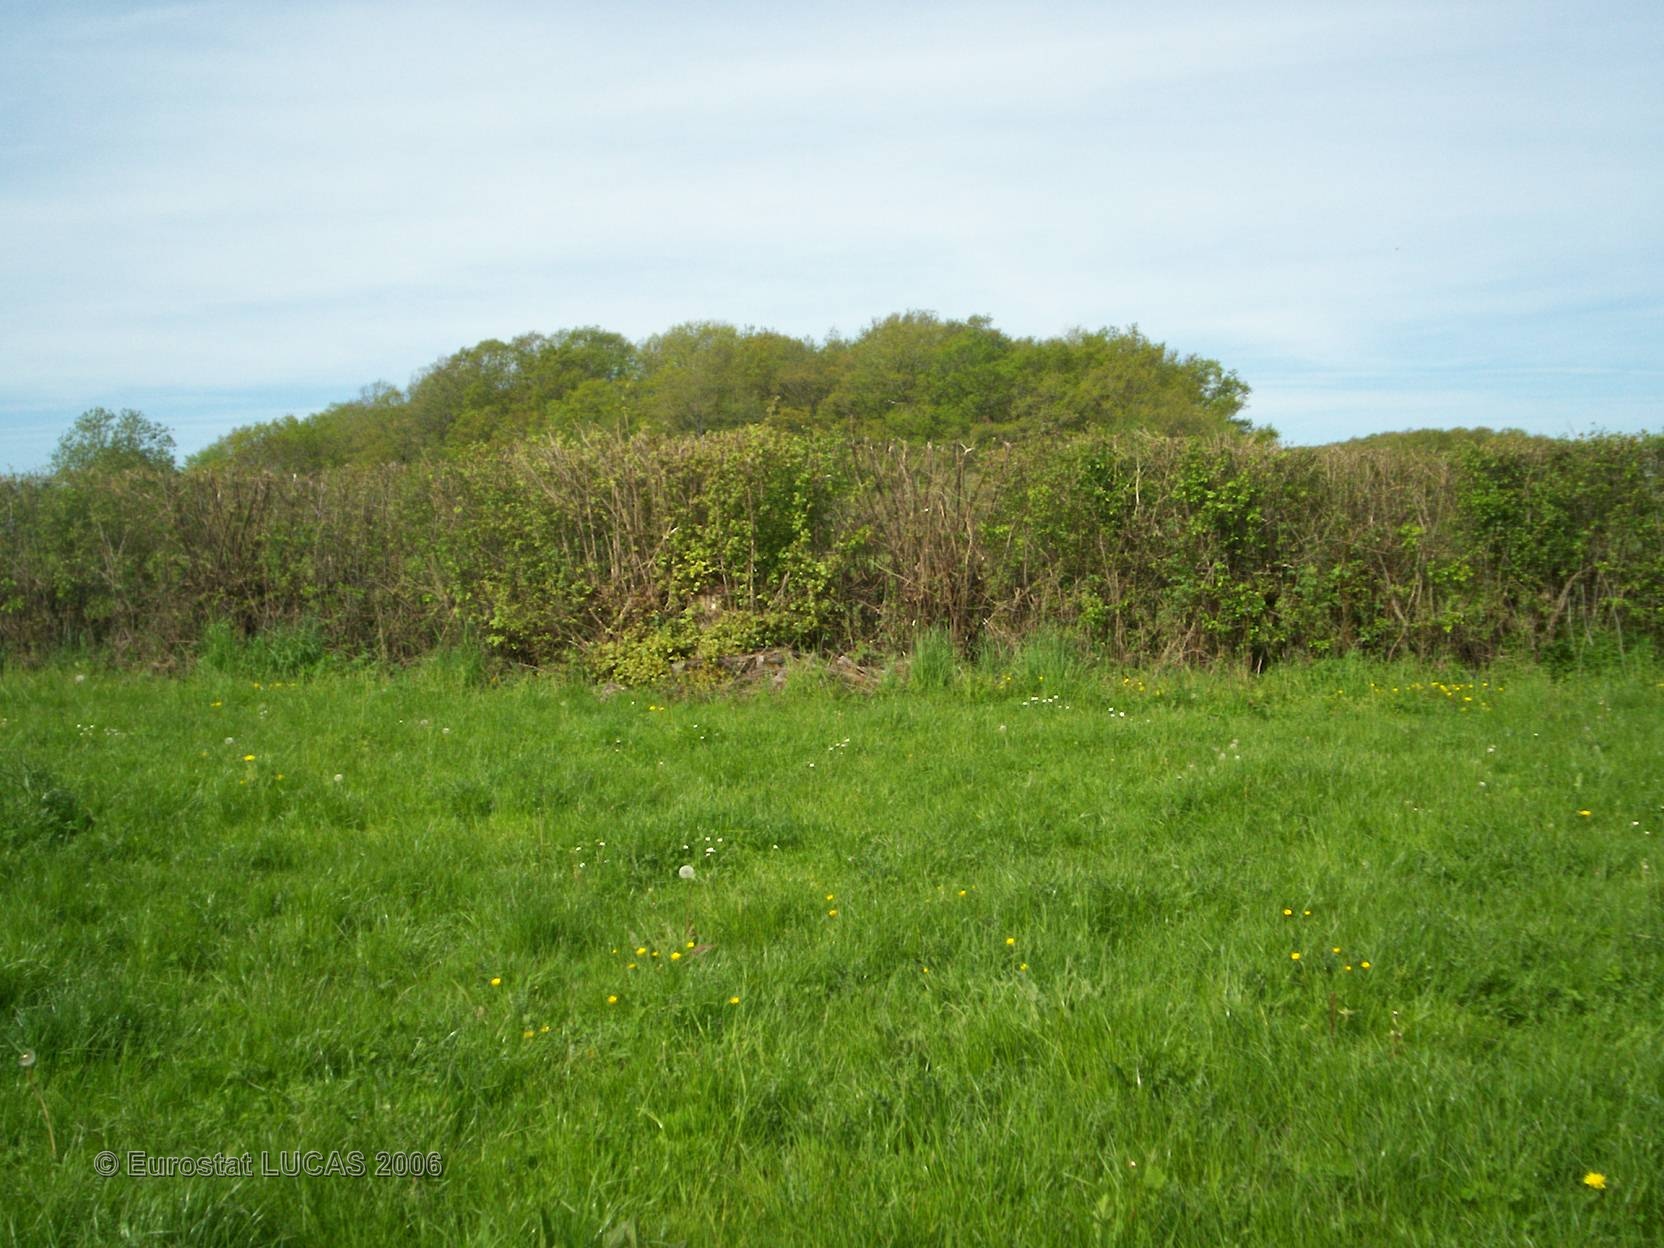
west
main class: Grassland
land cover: Grassland with sparse tree/shrub cover
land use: Agriculture (excluding fallow land and kitchen gardens)
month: May
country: FR
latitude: 46.3663
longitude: 3.1479
